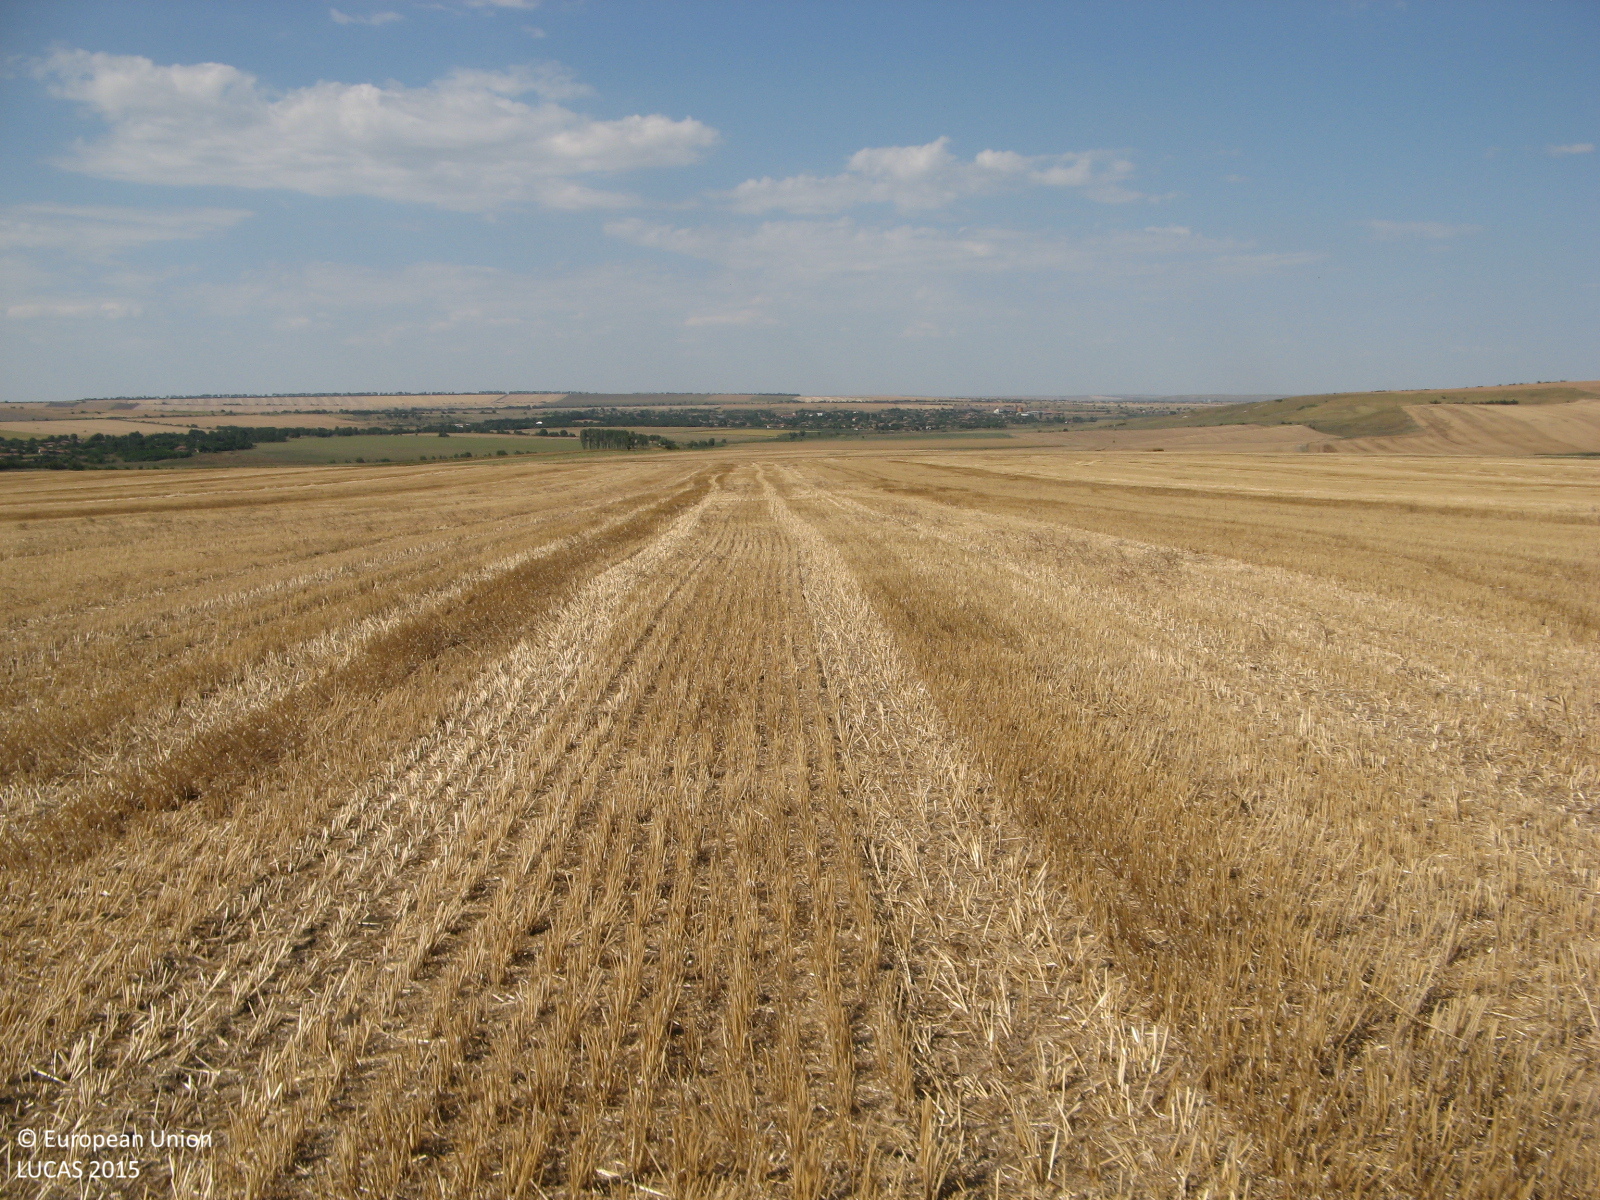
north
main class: Cropland
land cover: Common wheat
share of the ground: 50 - 75 %
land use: Agriculture (excluding fallow land and kitchen gardens)
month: August
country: BG
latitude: 43.4297
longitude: 25.4091
